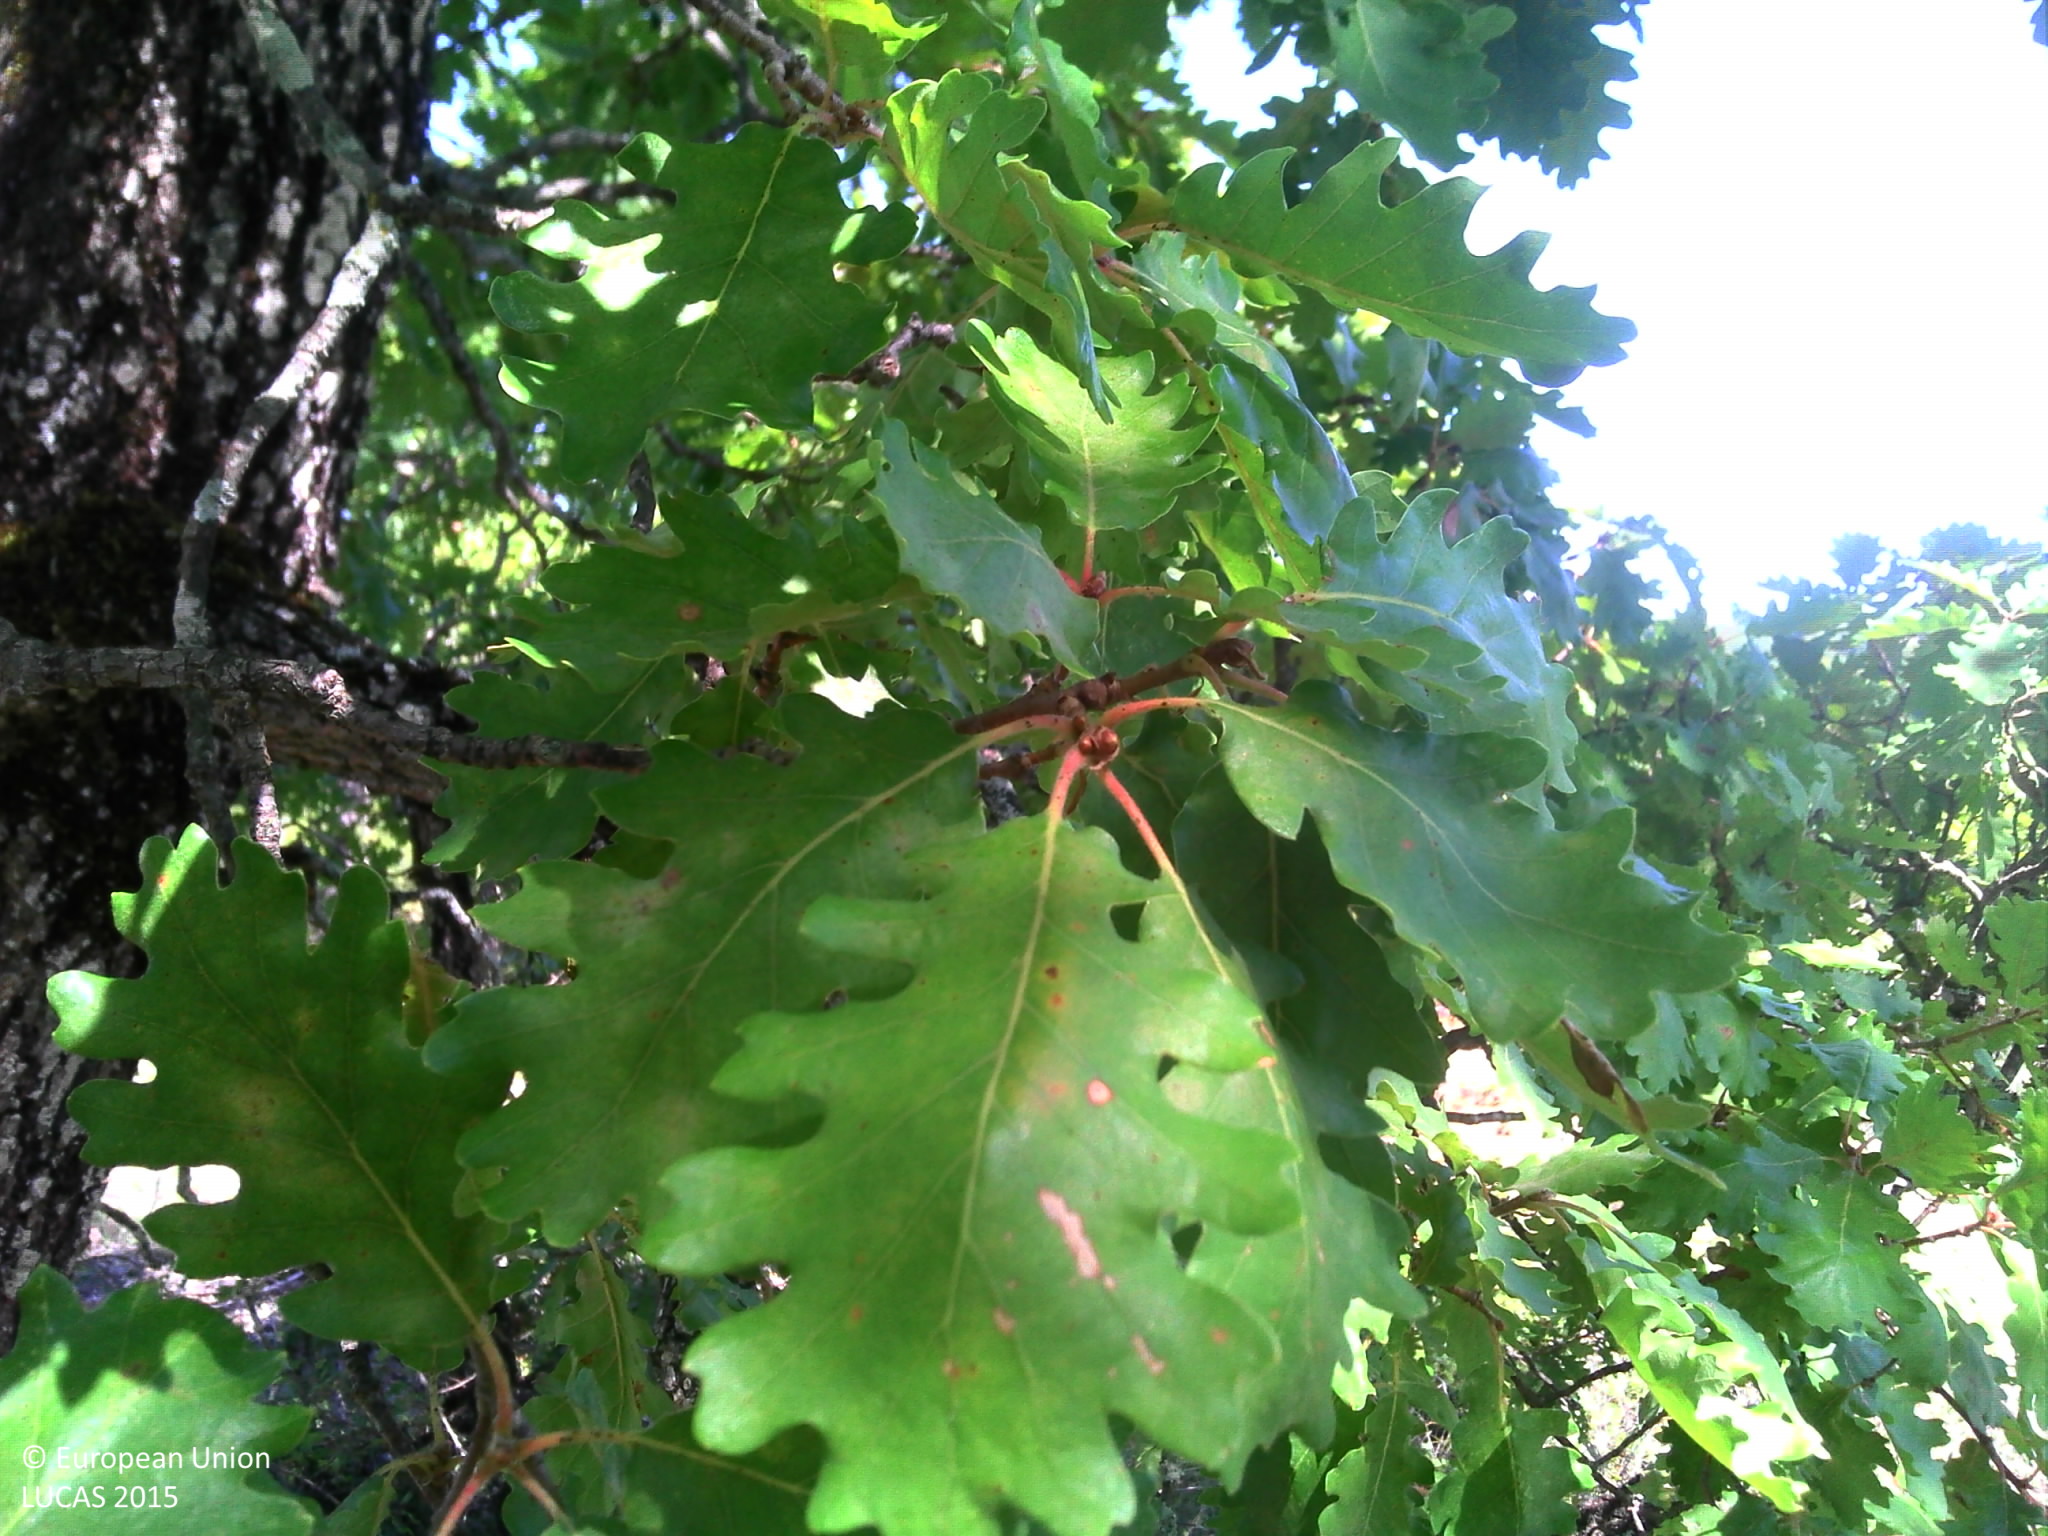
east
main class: Woodland
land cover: Broadleaved woodland
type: thermophilous deciduous forest
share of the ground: > 75 %
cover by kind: broadleaved forest trees 50 %, herbaceous plants 35 %, shrubs 10 %, lichens and mosses 5 %
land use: Forestry
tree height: > 5 m
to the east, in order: Broadleaved woodland; Other bare soil; Broadleaved woodland; Grassland with sparse tree/shrub cover
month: August
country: FR
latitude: 44.3263
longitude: 1.4845
